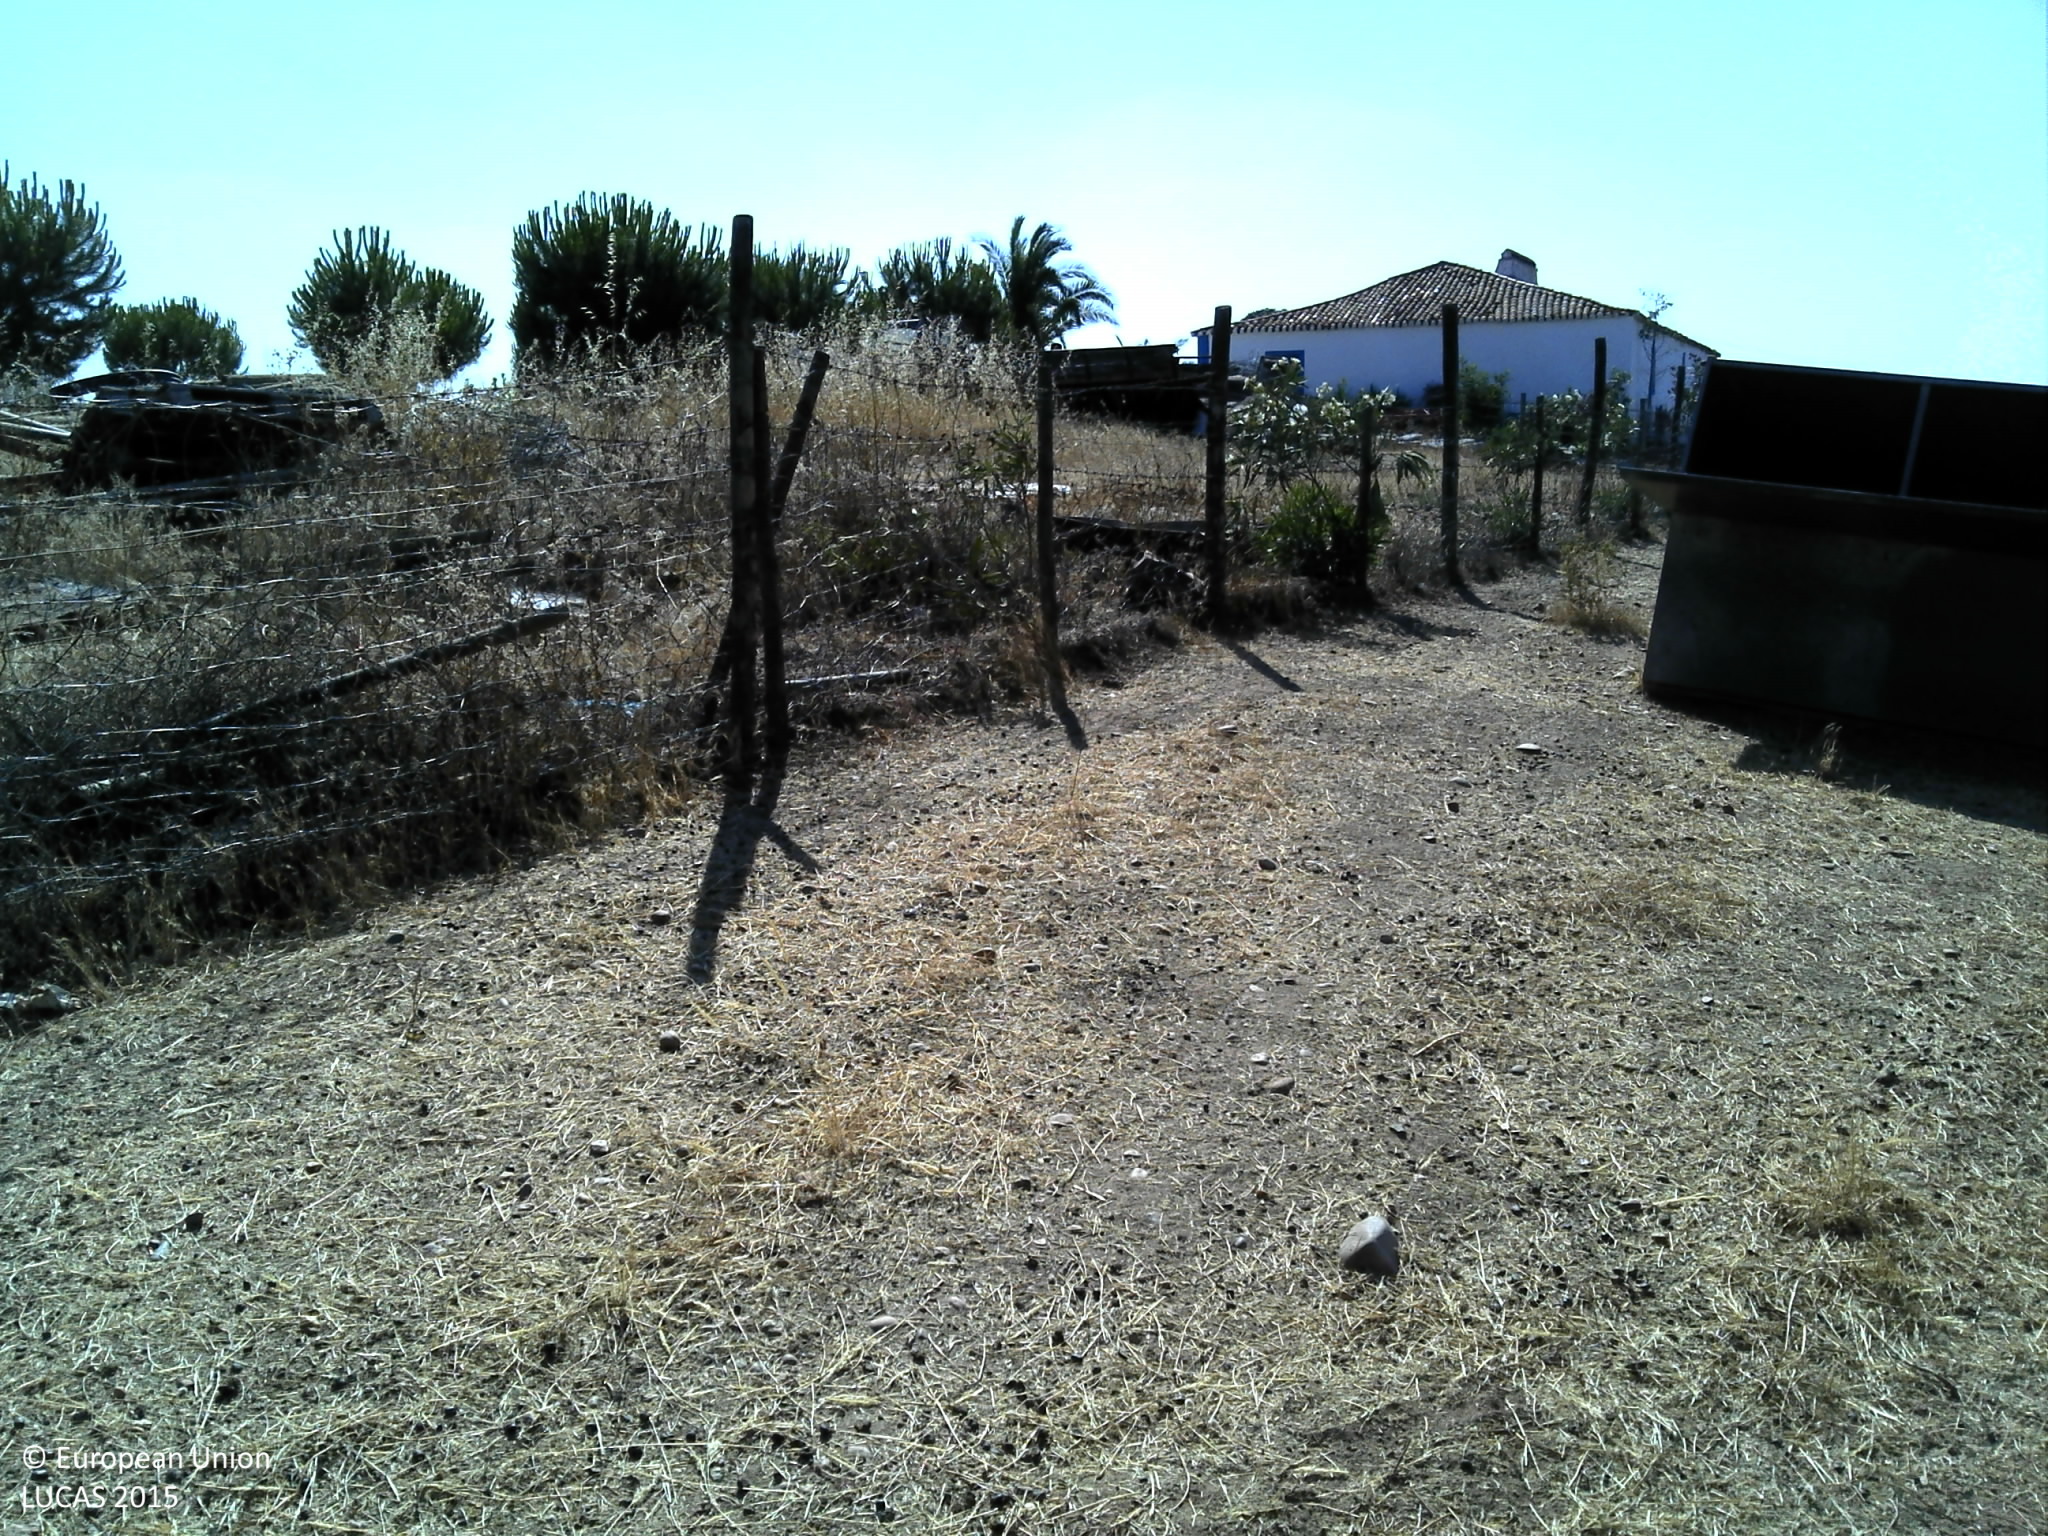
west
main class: Grassland
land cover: Grassland with sparse tree/shrub cover
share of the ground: 25 - 50 %
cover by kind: herbaceous plants 50 %, unconsolidated bare surface 45 %, broadleaved forest trees 5 %
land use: Agriculture (excluding fallow land and kitchen gardens)
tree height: < 5 m
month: June
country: PT
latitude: 38.0999
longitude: -7.6426
